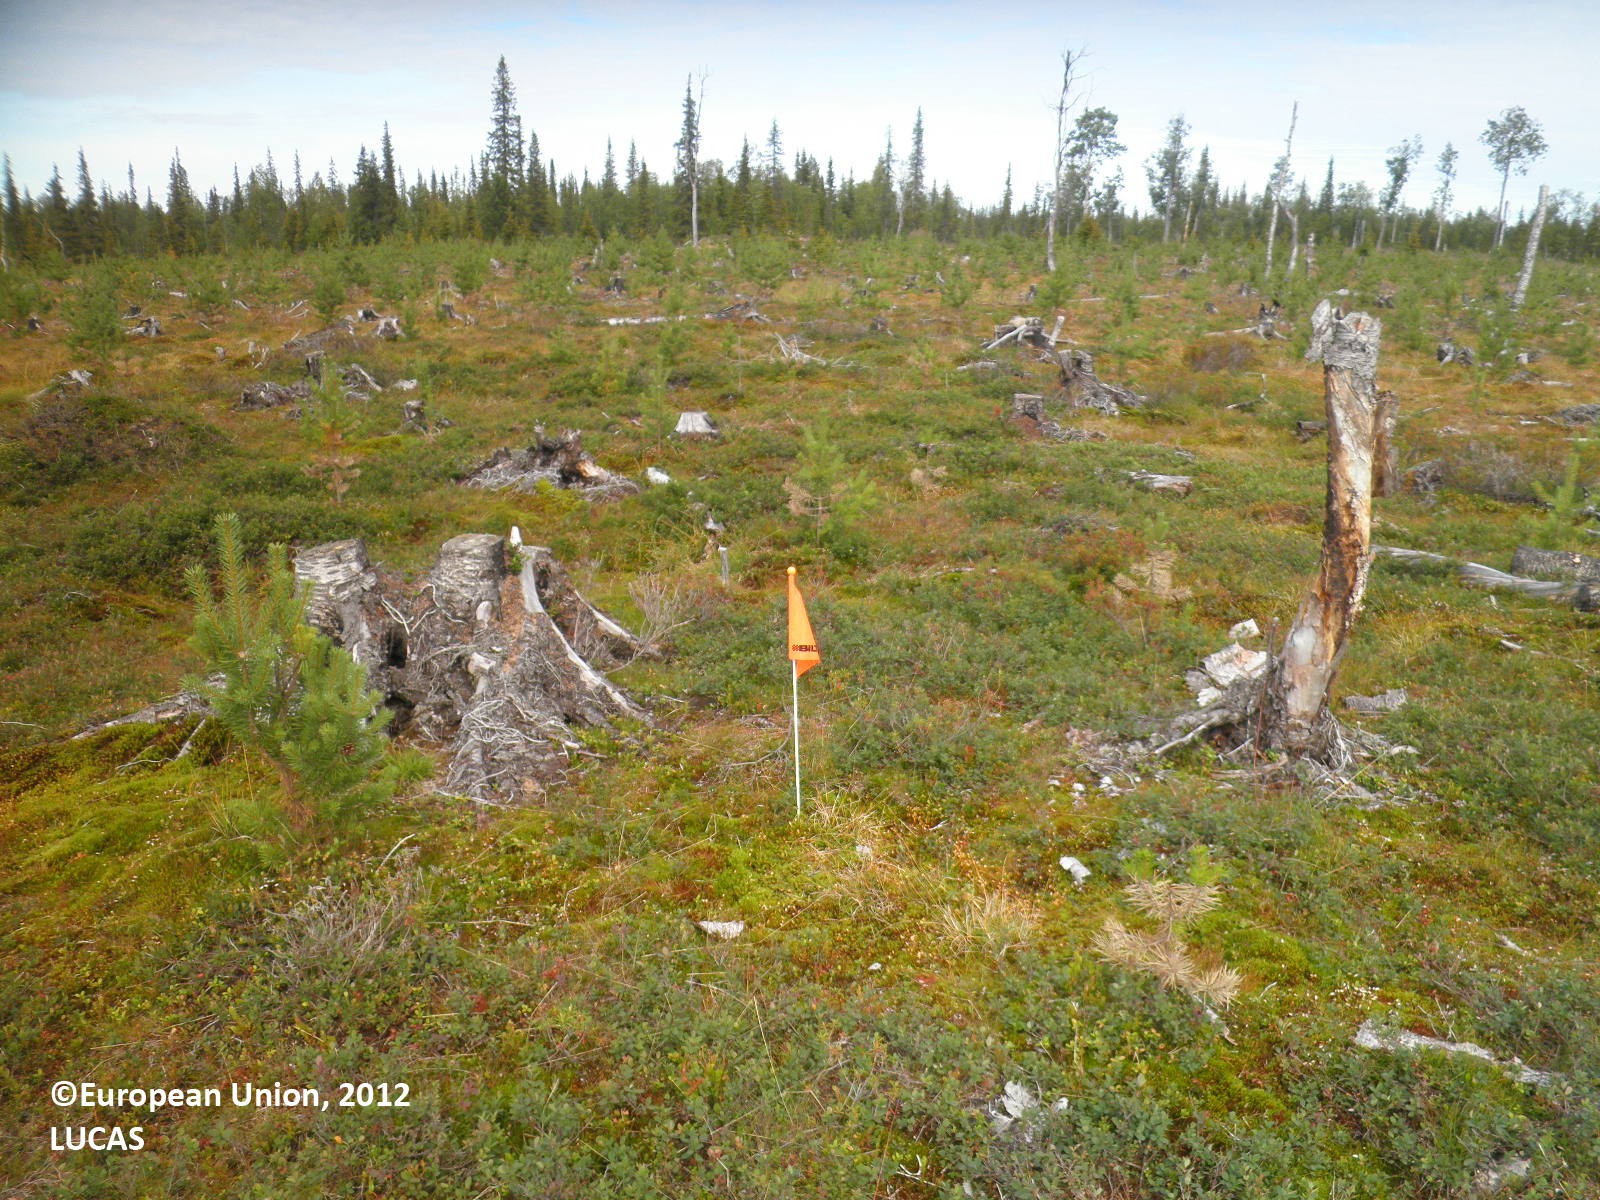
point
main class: Grassland
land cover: Grassland with sparse tree/shrub cover
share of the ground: > 75 %
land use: Forestry
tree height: < 5 m
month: August
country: FI
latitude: 67.7609
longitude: 26.3288
